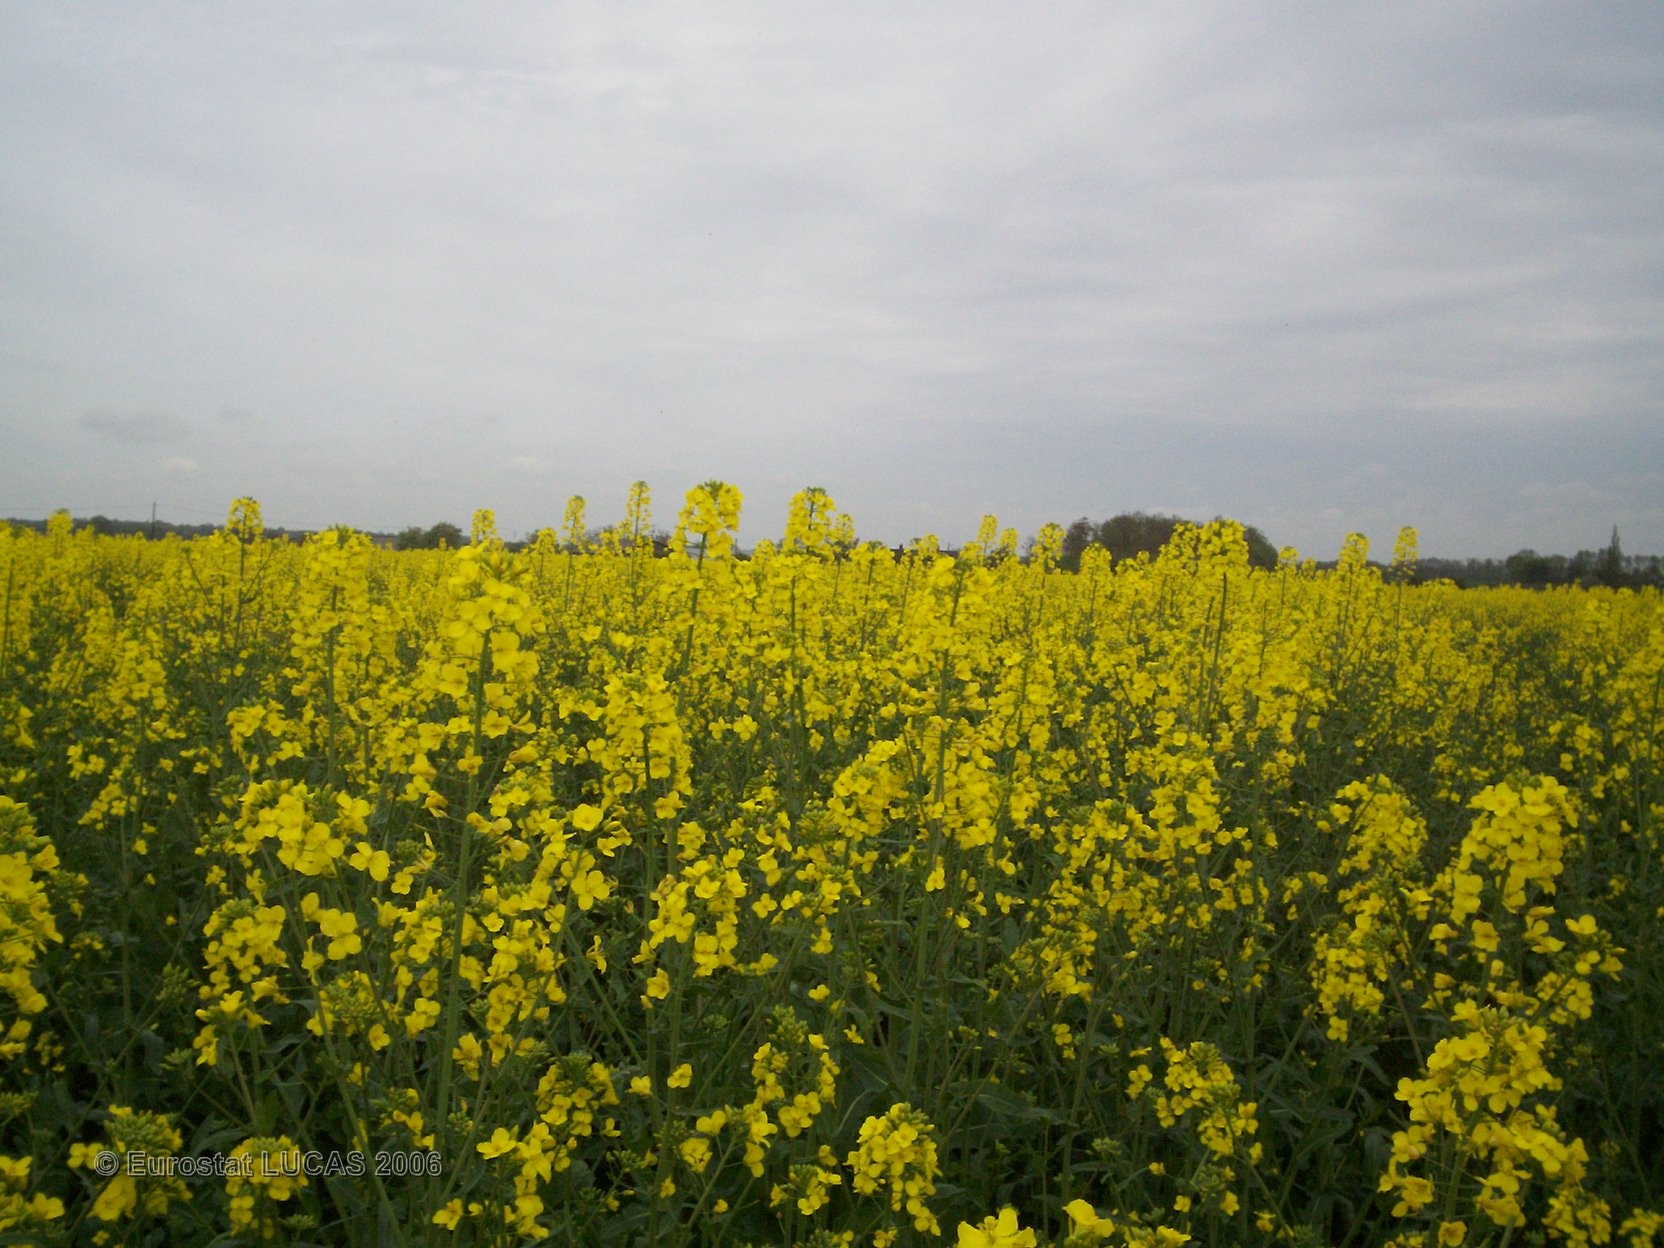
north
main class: Cropland
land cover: Rape and turnip rape
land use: Agriculture (excluding fallow land and kitchen gardens)
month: May
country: FR
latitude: 48.8724
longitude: 0.6088
